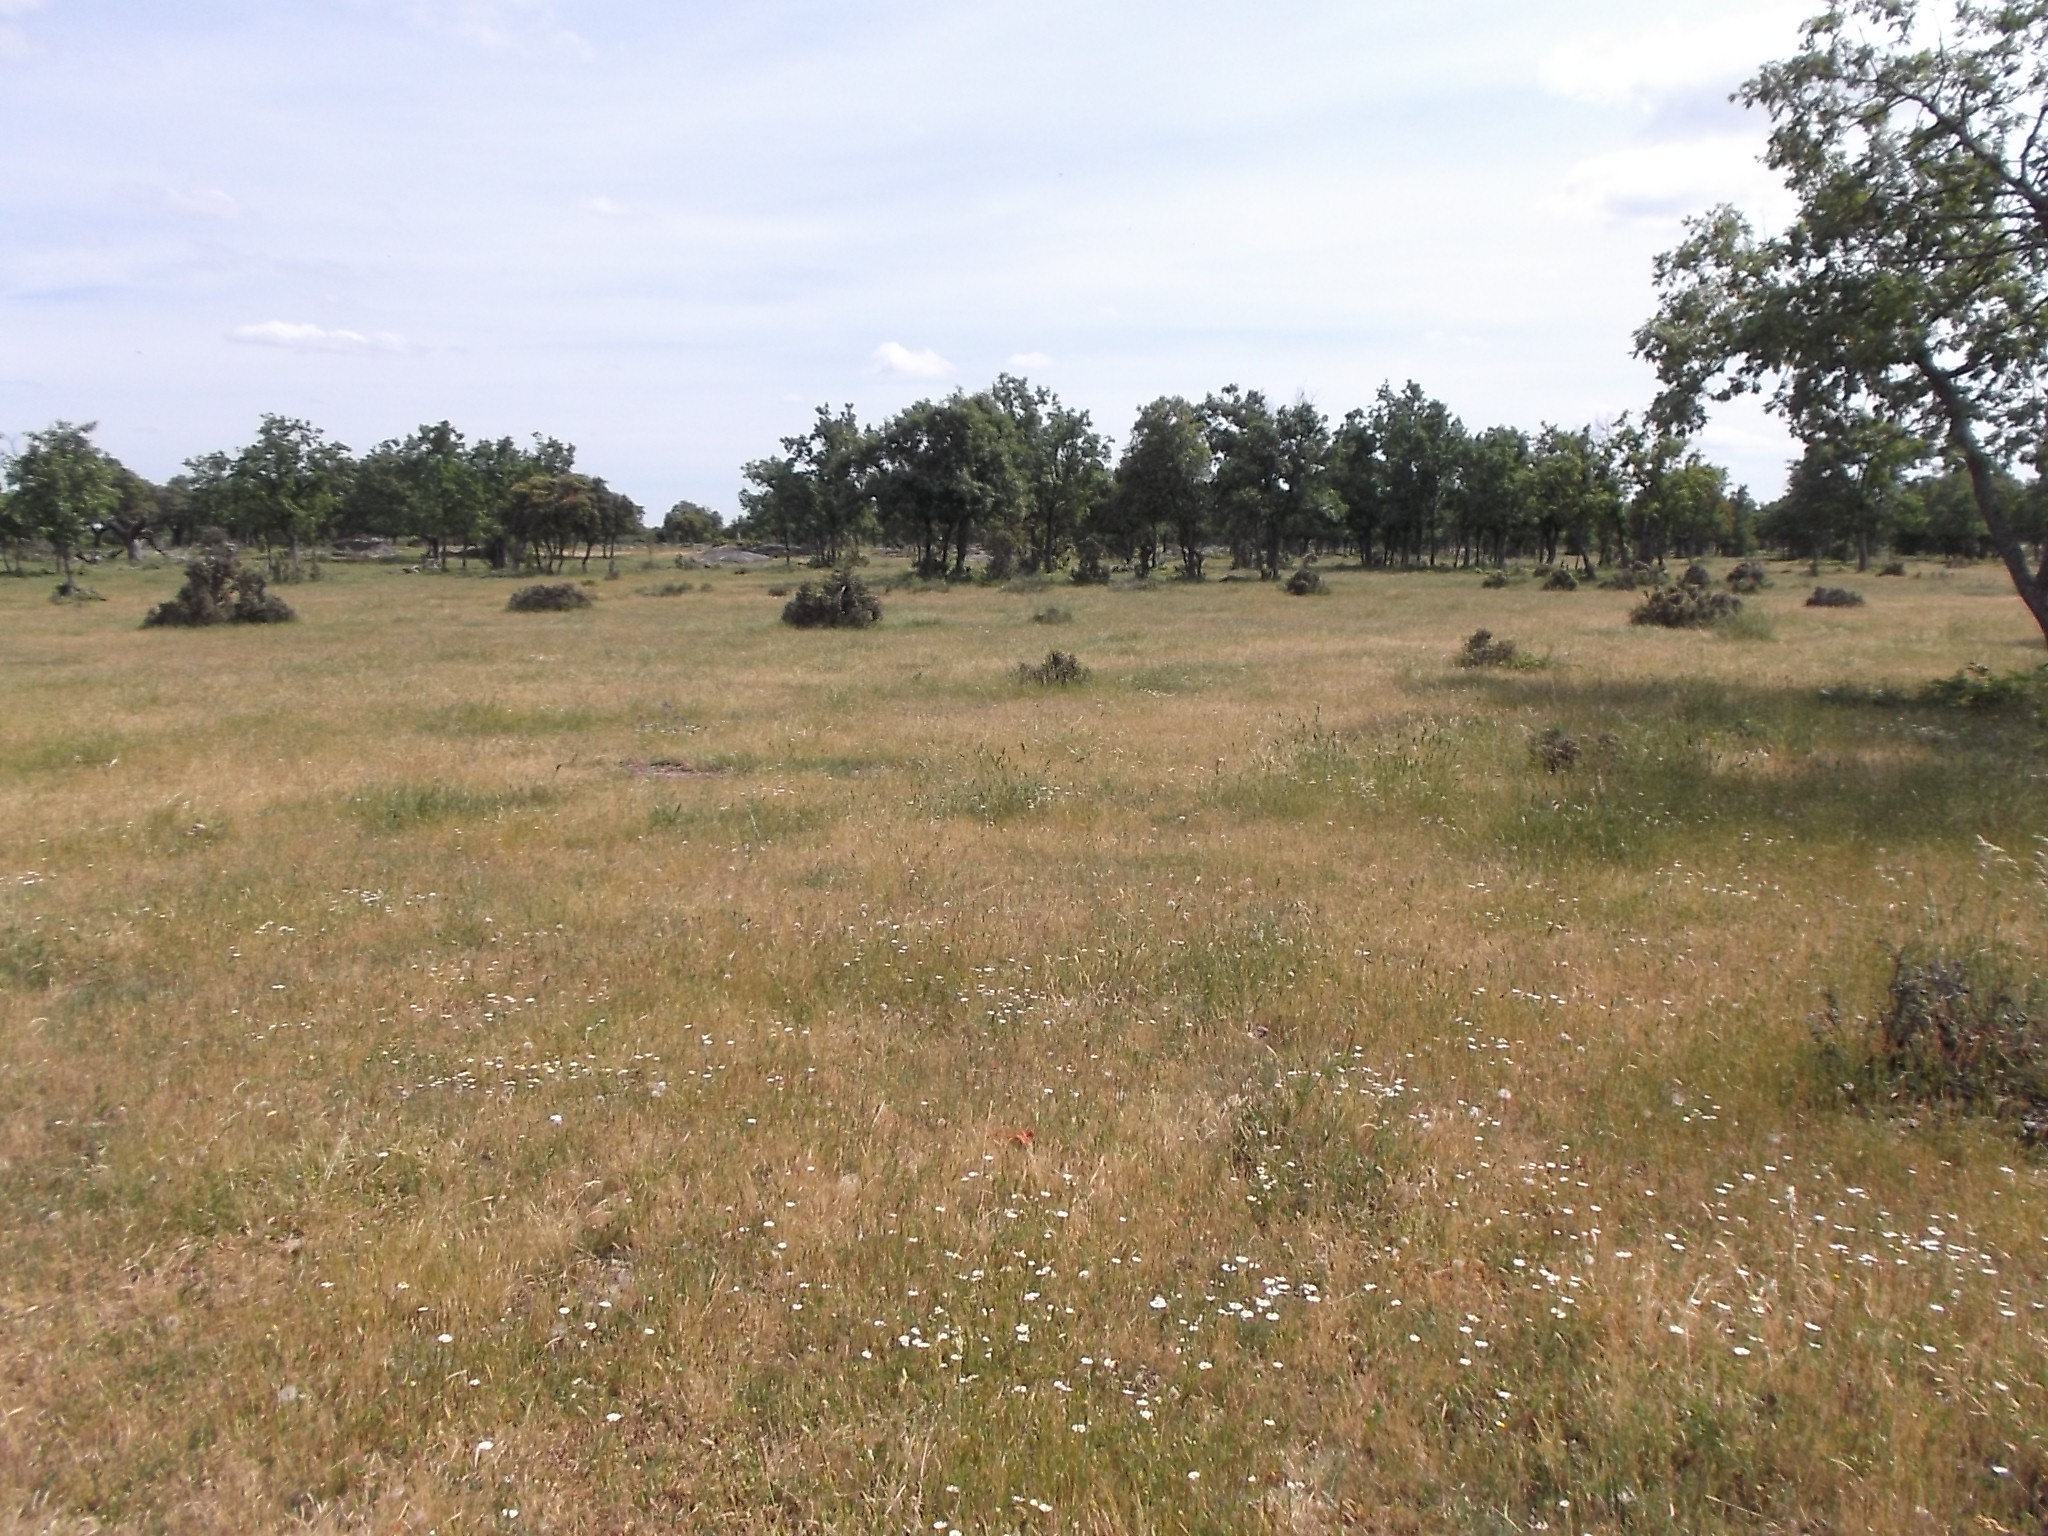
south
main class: Grassland
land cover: Grassland with sparse tree/shrub cover
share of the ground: > 75 %
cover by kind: herbaceous plants 90 %, broadleaved forest trees 5 %, shrubs 5 %
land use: Agriculture (excluding fallow land and kitchen gardens)
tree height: < 5 m
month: May
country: ES
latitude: 41.1205
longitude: -6.3025
